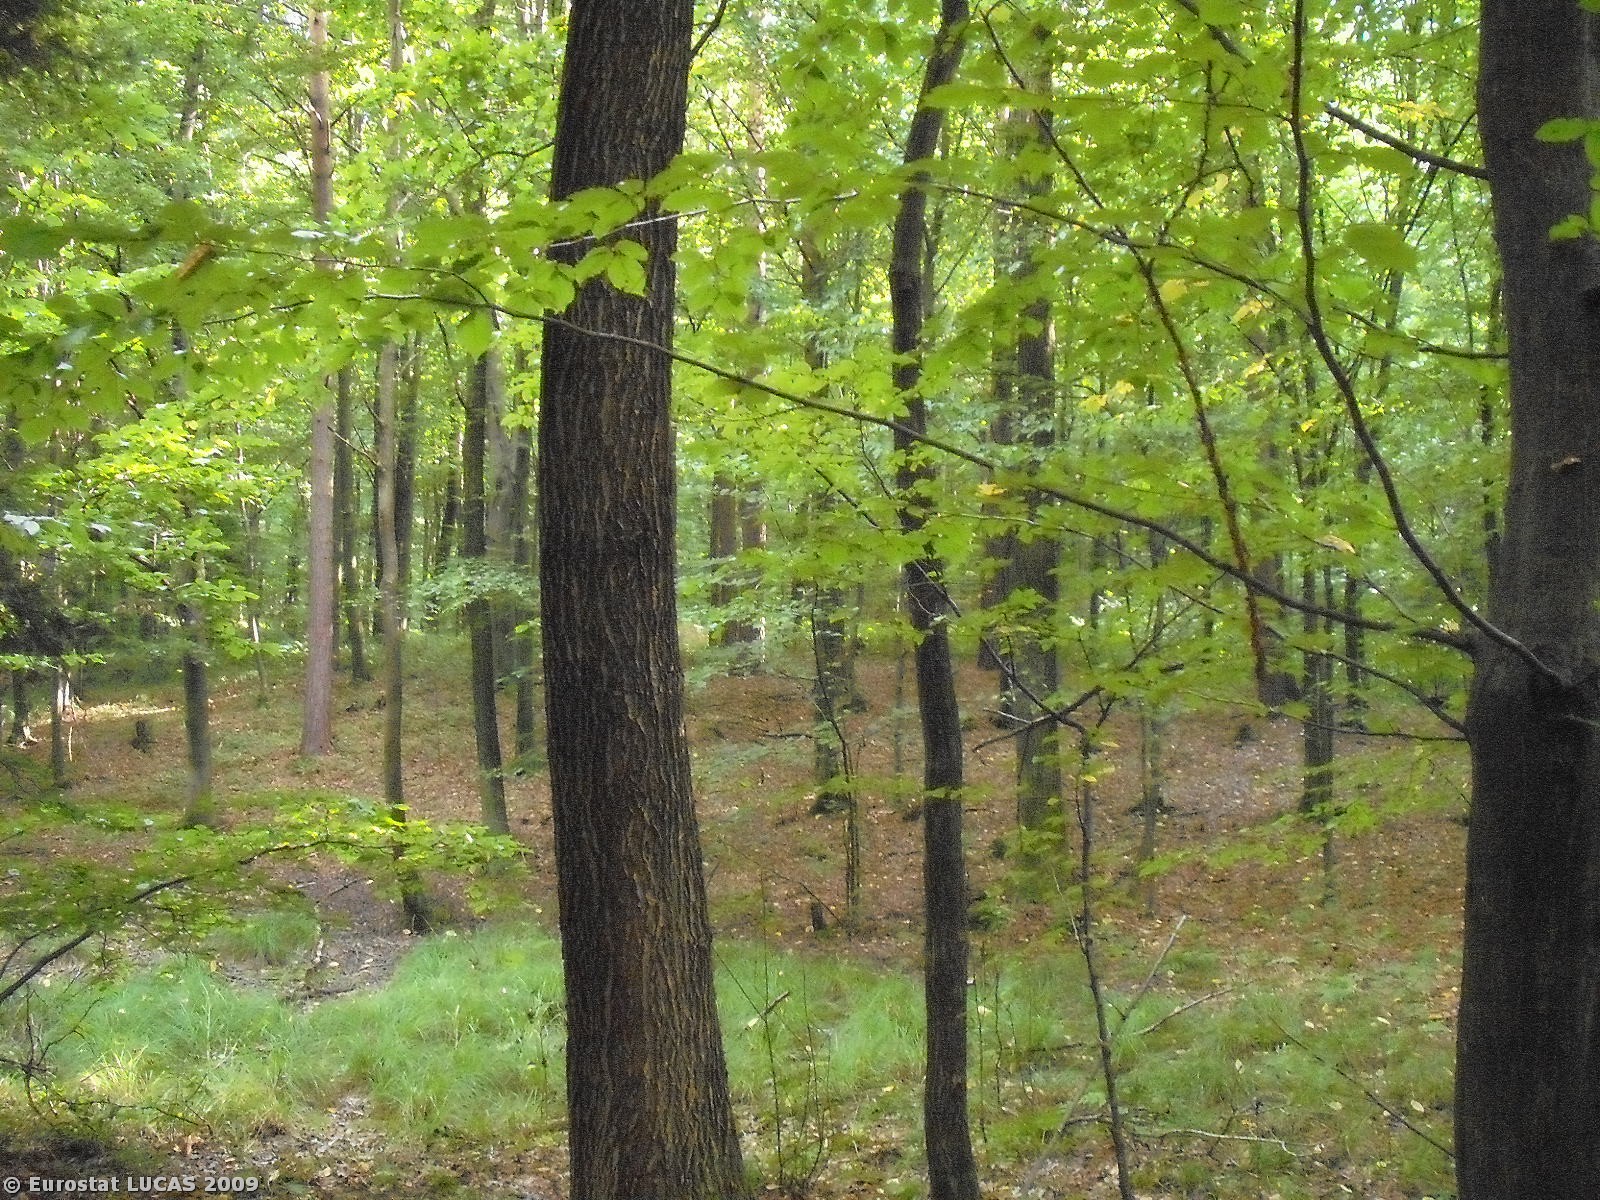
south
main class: Woodland
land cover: Broadleaved woodland
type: mesophytic deciduous forest
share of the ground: > 75 %
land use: Forestry
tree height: > 5 m
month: September
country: PL
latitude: 49.9241
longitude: 22.0510
